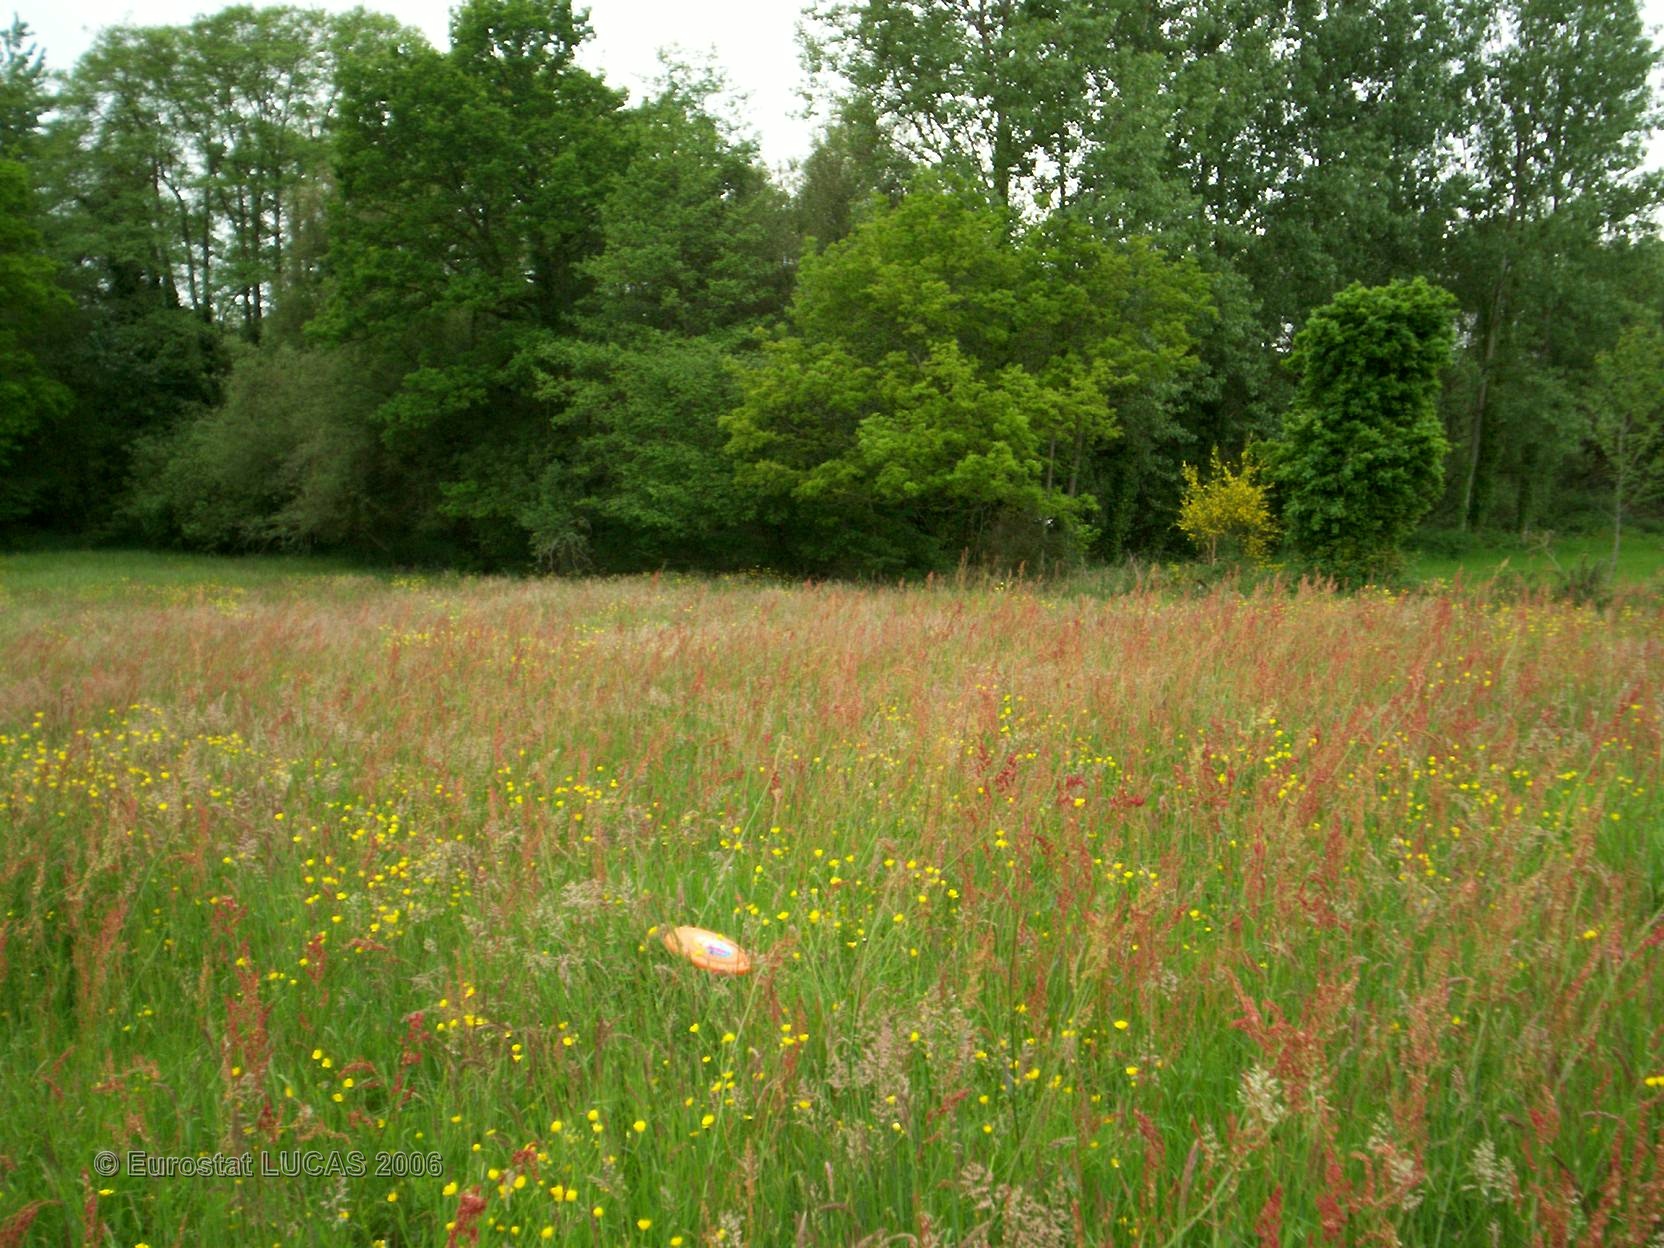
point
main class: Grassland
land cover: Grassland without tree/shrub cover
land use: Agriculture (excluding fallow land and kitchen gardens)
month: May
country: FR
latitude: 48.3243
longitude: -2.3728
